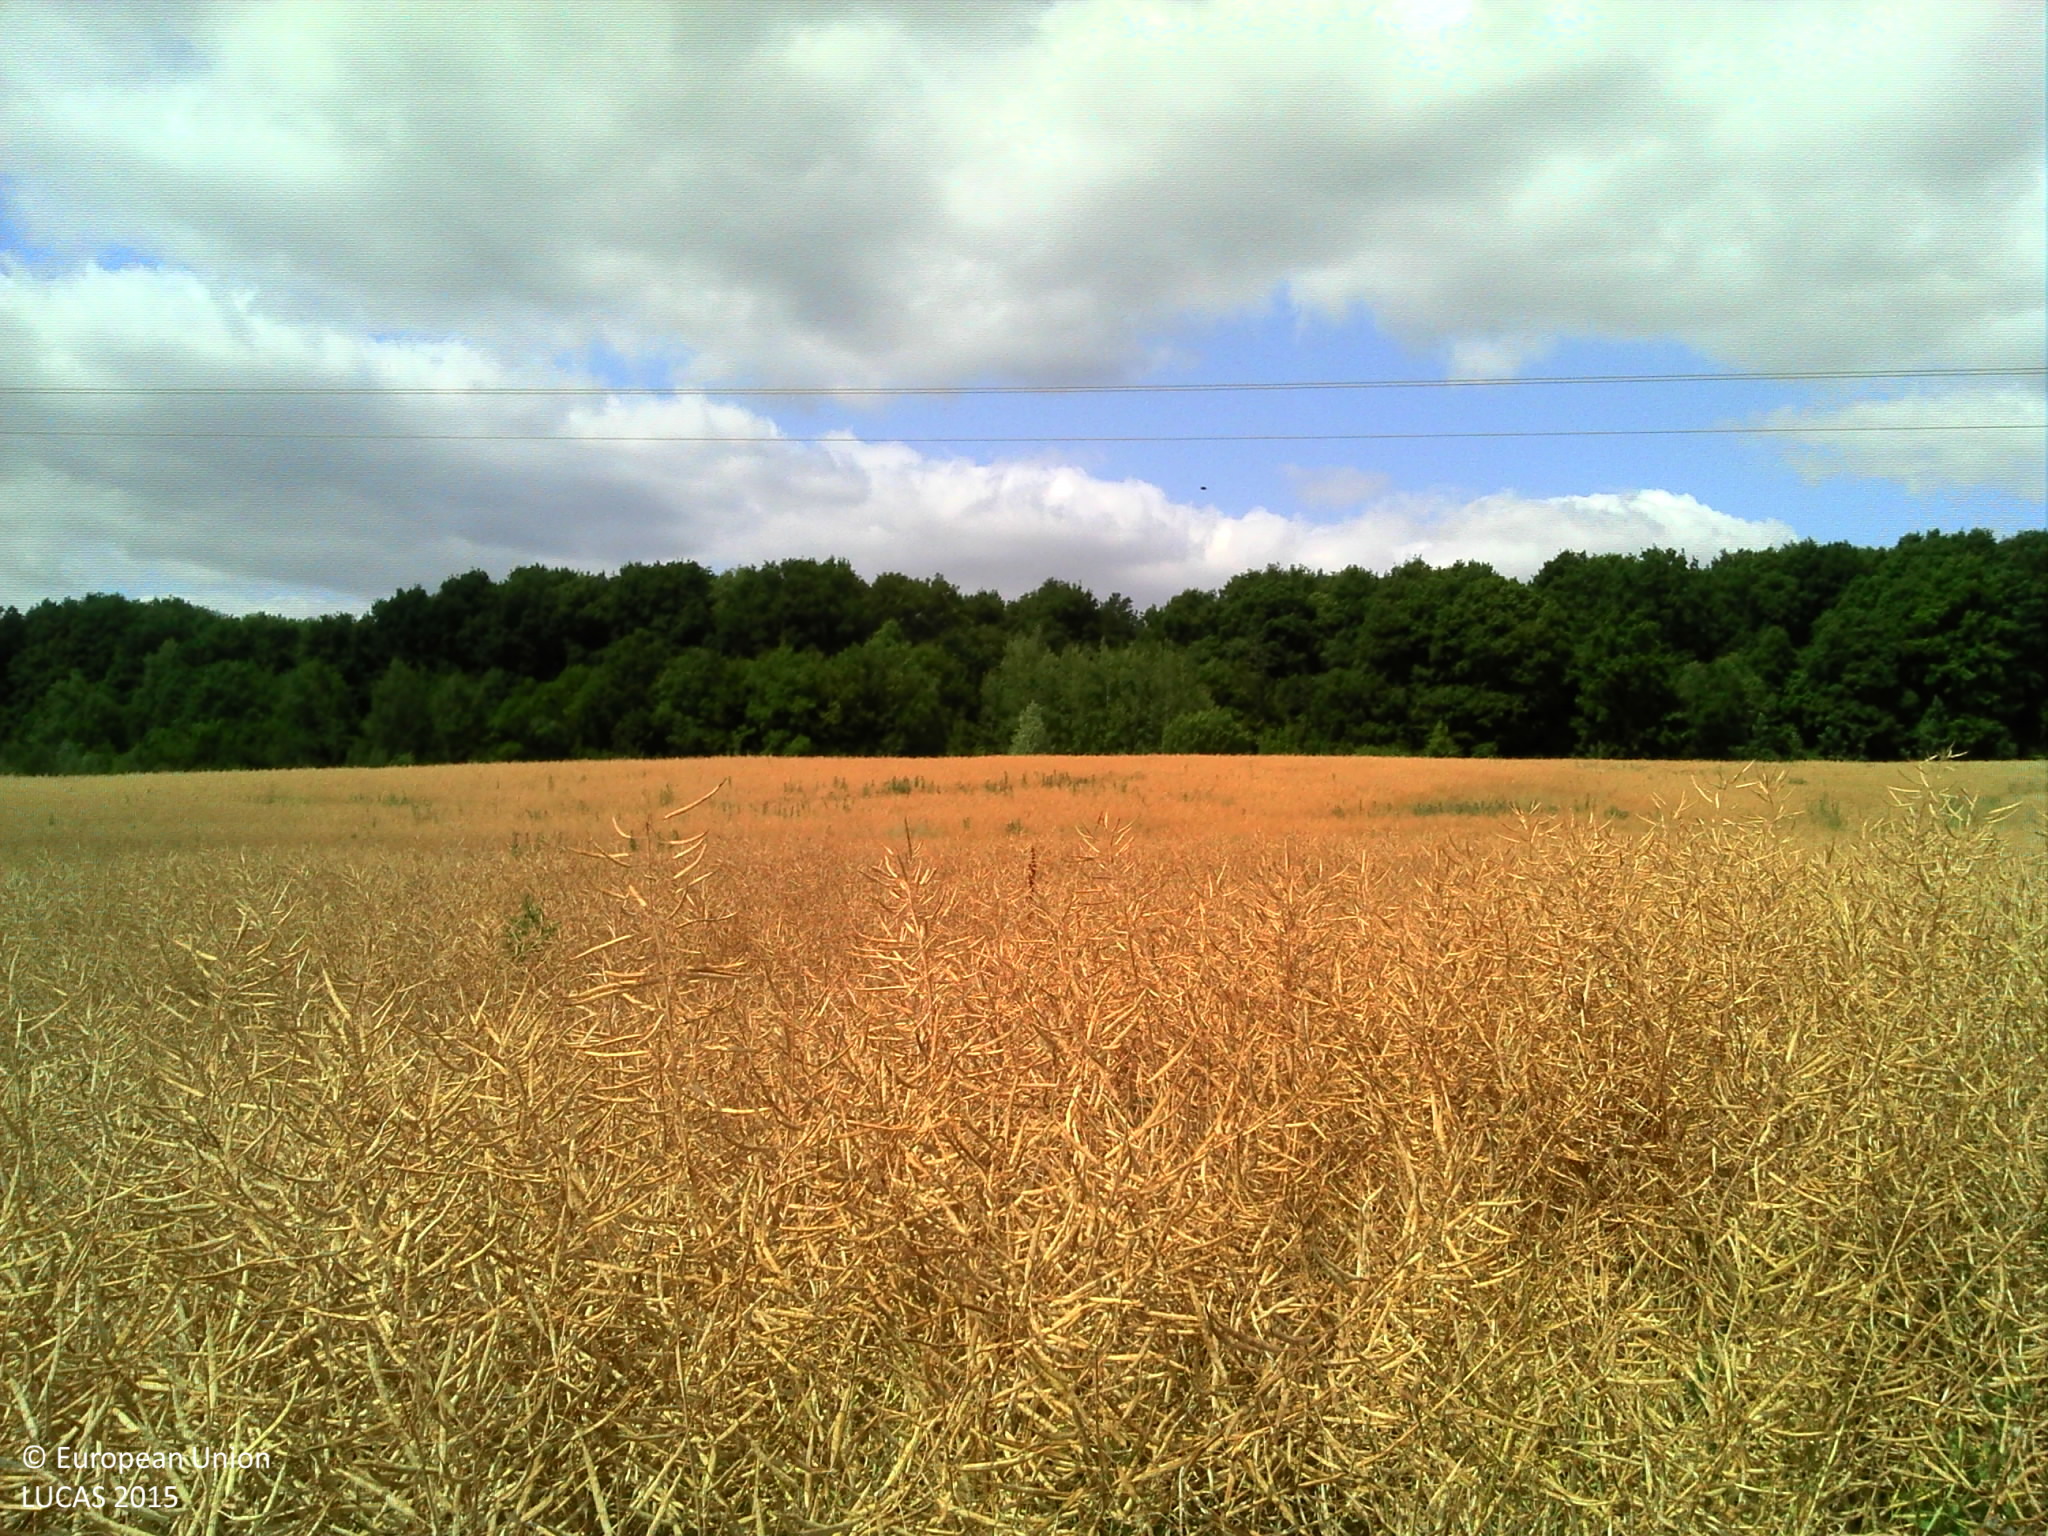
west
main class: Cropland
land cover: Rape and turnip rape
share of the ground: > 75 %
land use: Agriculture (excluding fallow land and kitchen gardens)
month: July
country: FR
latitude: 49.2942
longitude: 1.8302
